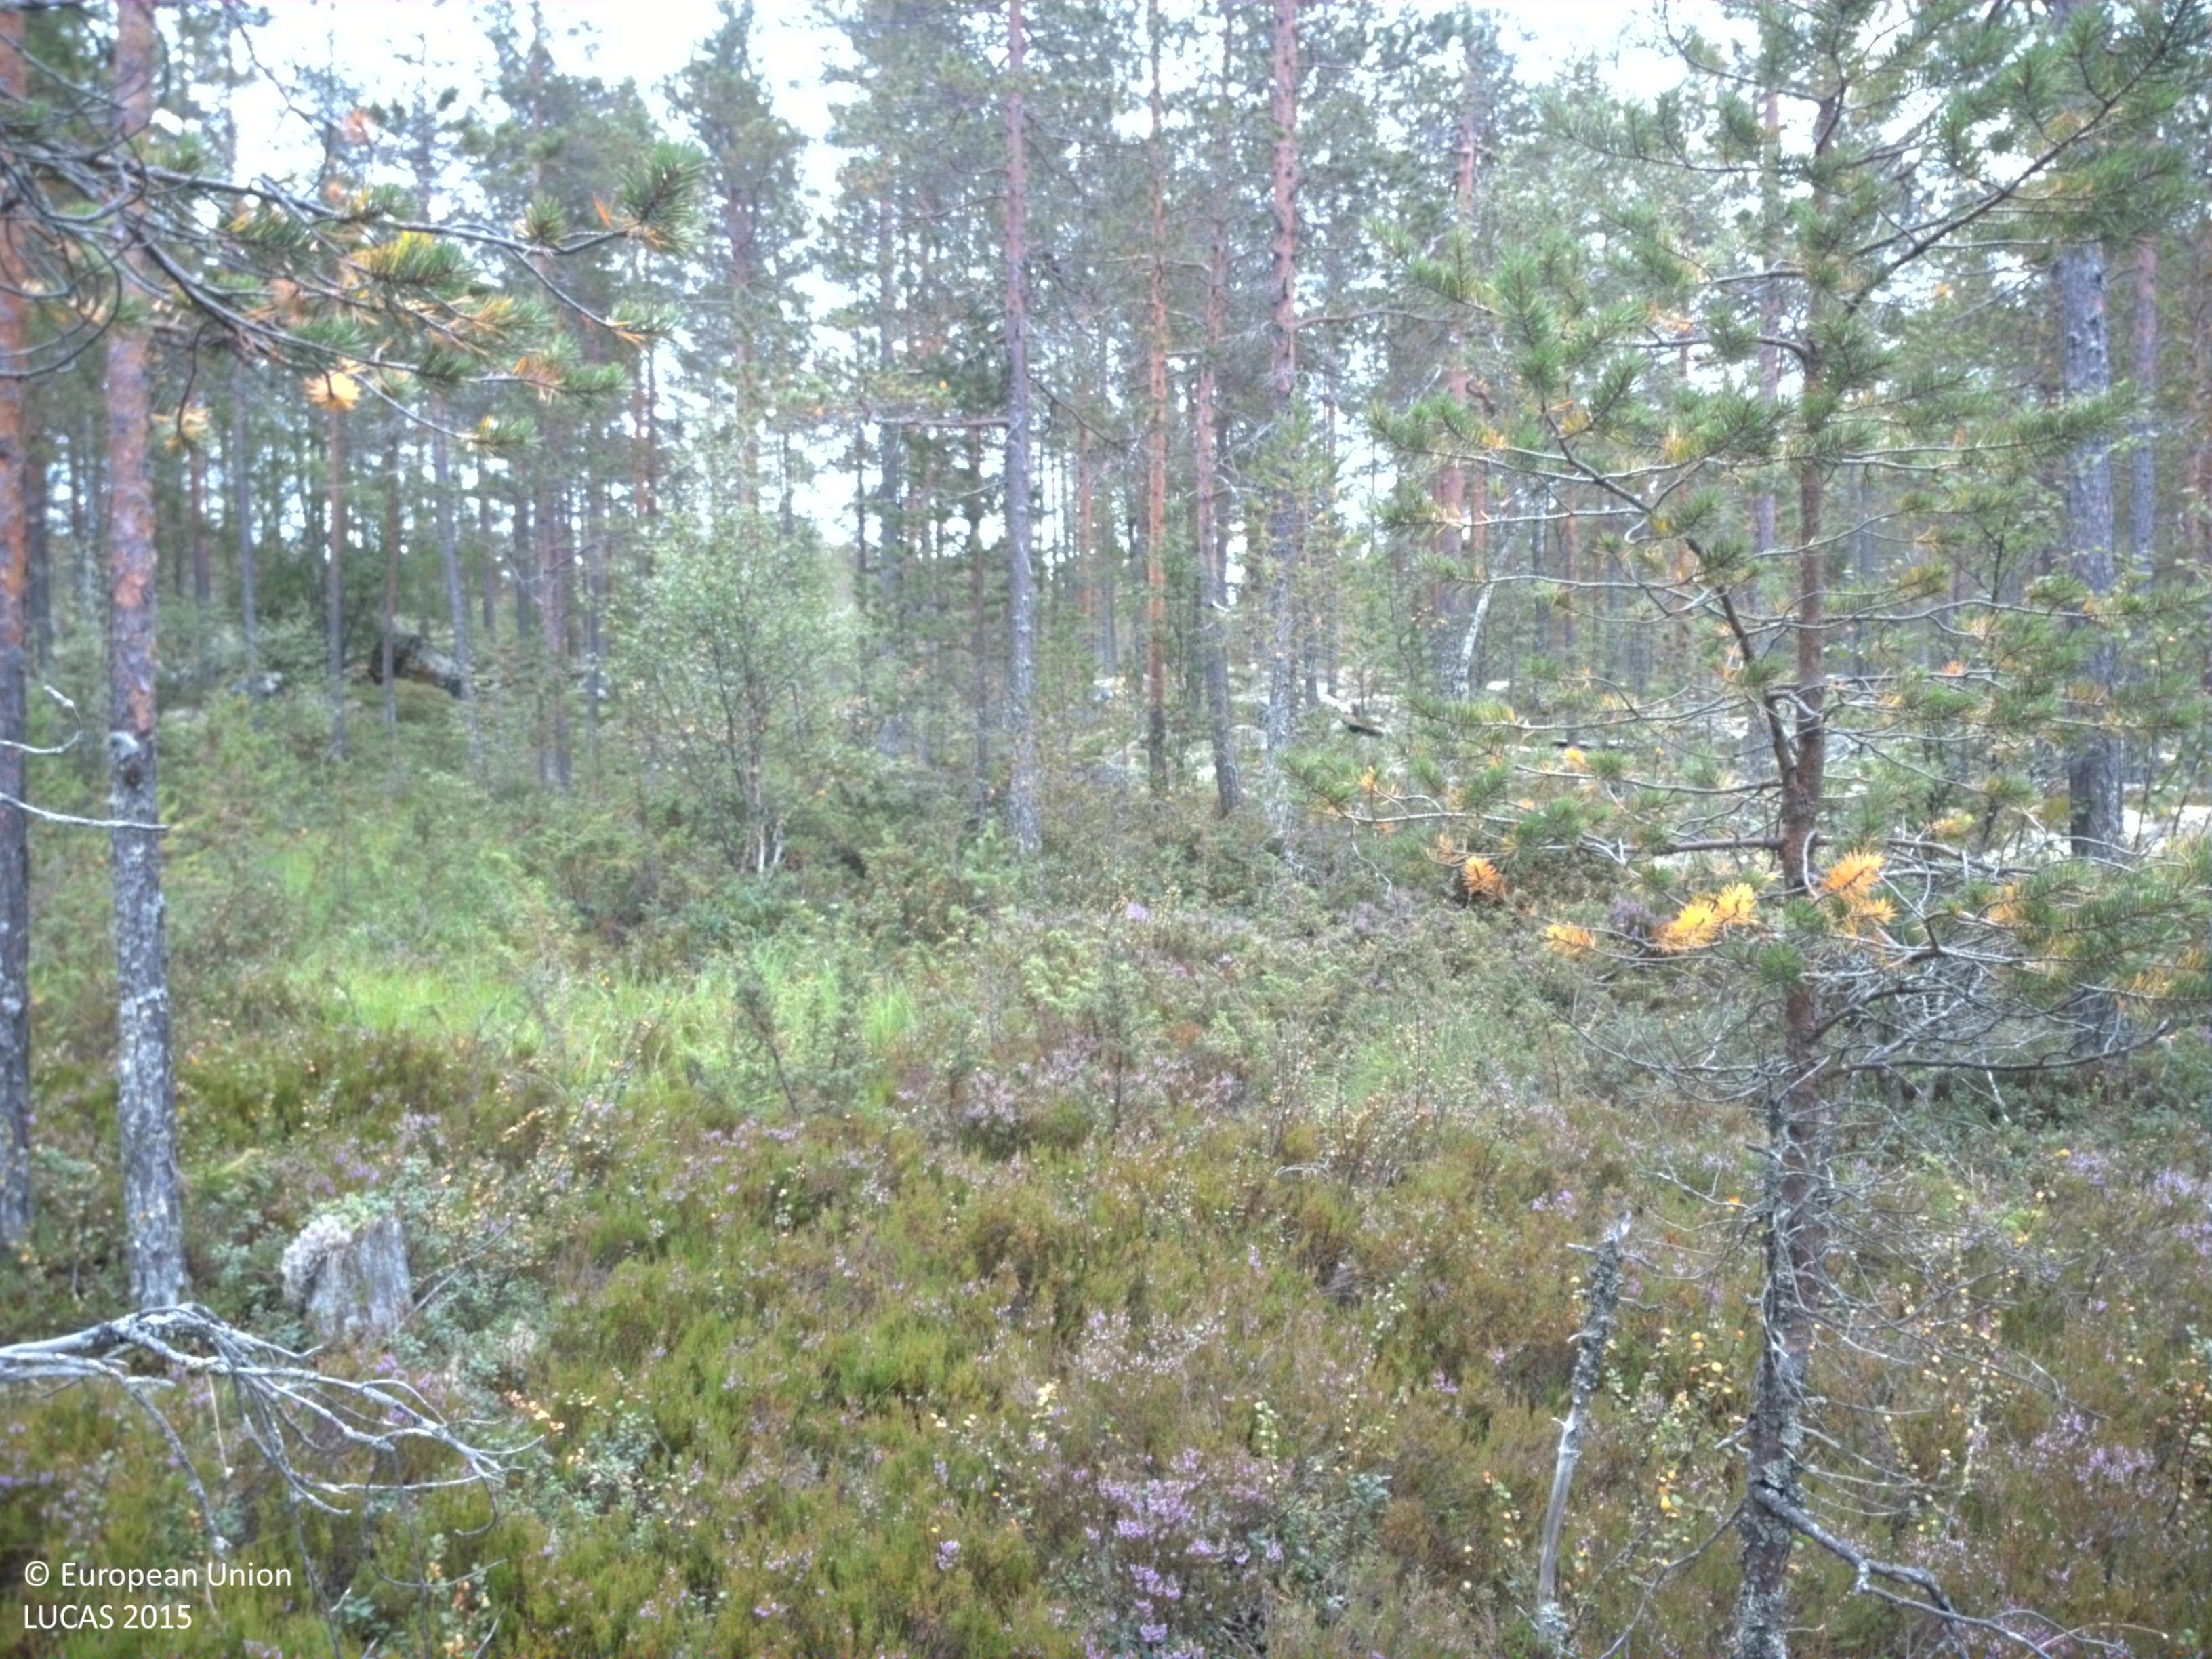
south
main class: Woodland
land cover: Pine dominated coniferous woodland
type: boreal forest
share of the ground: 25 - 50 %
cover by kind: coniferous forest trees 40 %, shrubs 40 %, lichens and mosses 15 %, broadleaved forest trees 5 %
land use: Forestry
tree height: > 5 m
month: August
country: SE
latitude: 61.6961
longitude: 15.0692
